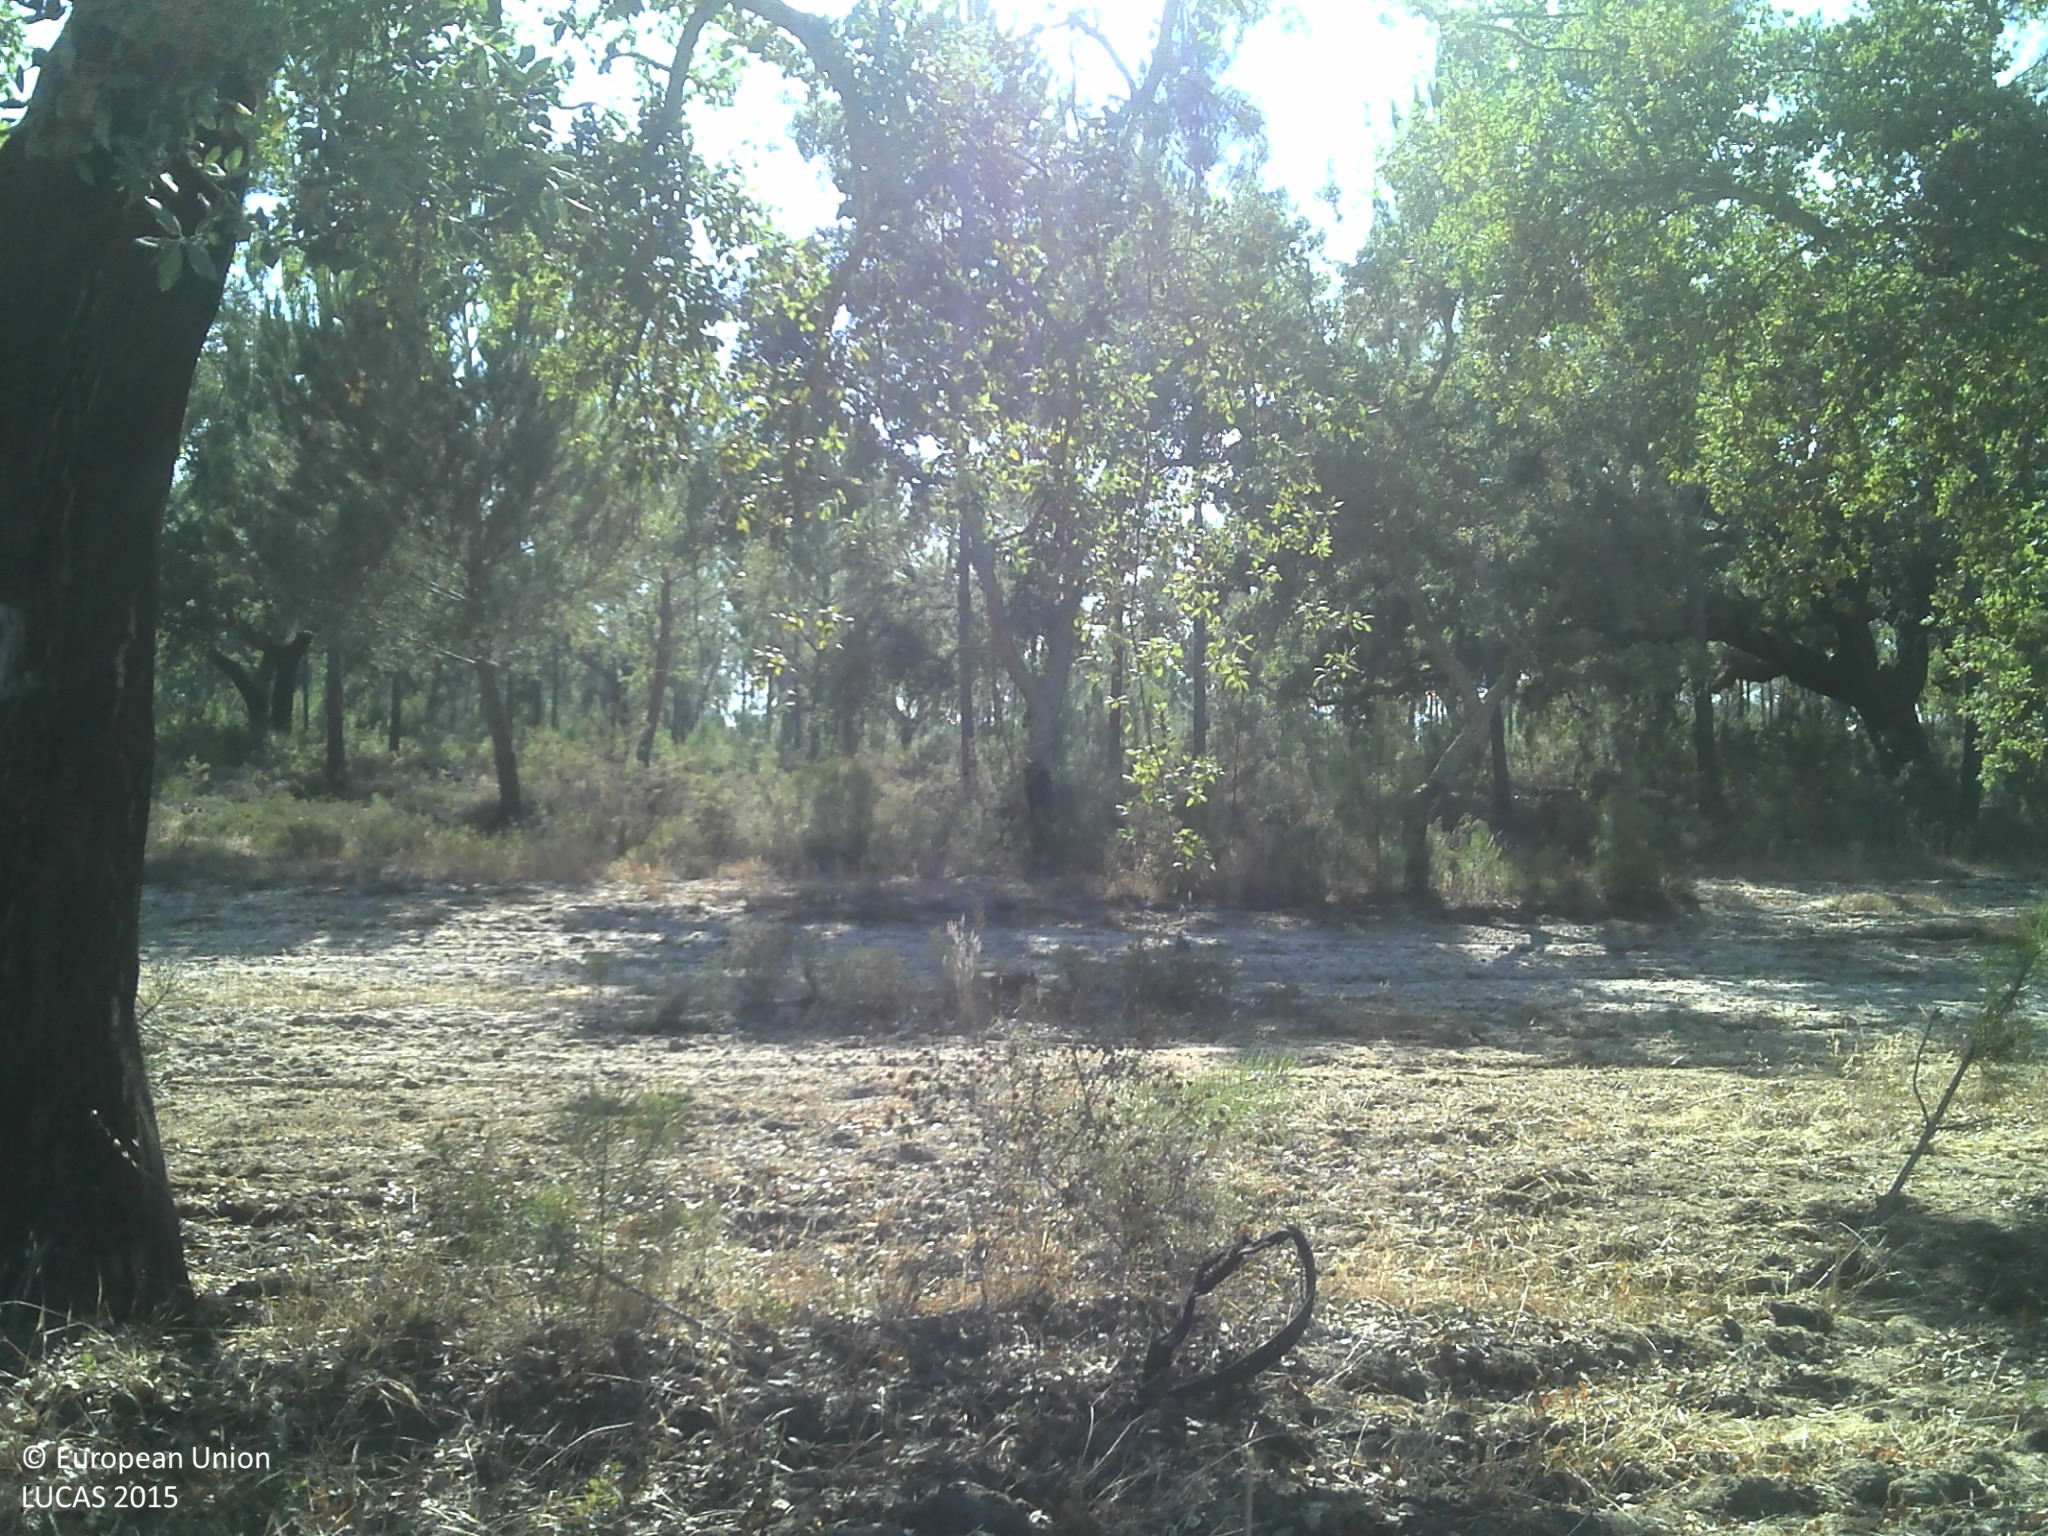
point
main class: Woodland
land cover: Pine dominated coniferous woodland
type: coniferous forest of the mediterranean region
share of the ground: 50 - 75 %
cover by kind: coniferous forest trees 65 %, unconsolidated bare surface 15 %, shrubs 10 %, broadleaved forest trees 5 %, herbaceous plants 5 %
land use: Forestry
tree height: > 5 m
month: July
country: PT
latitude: 38.9682
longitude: -8.6126
